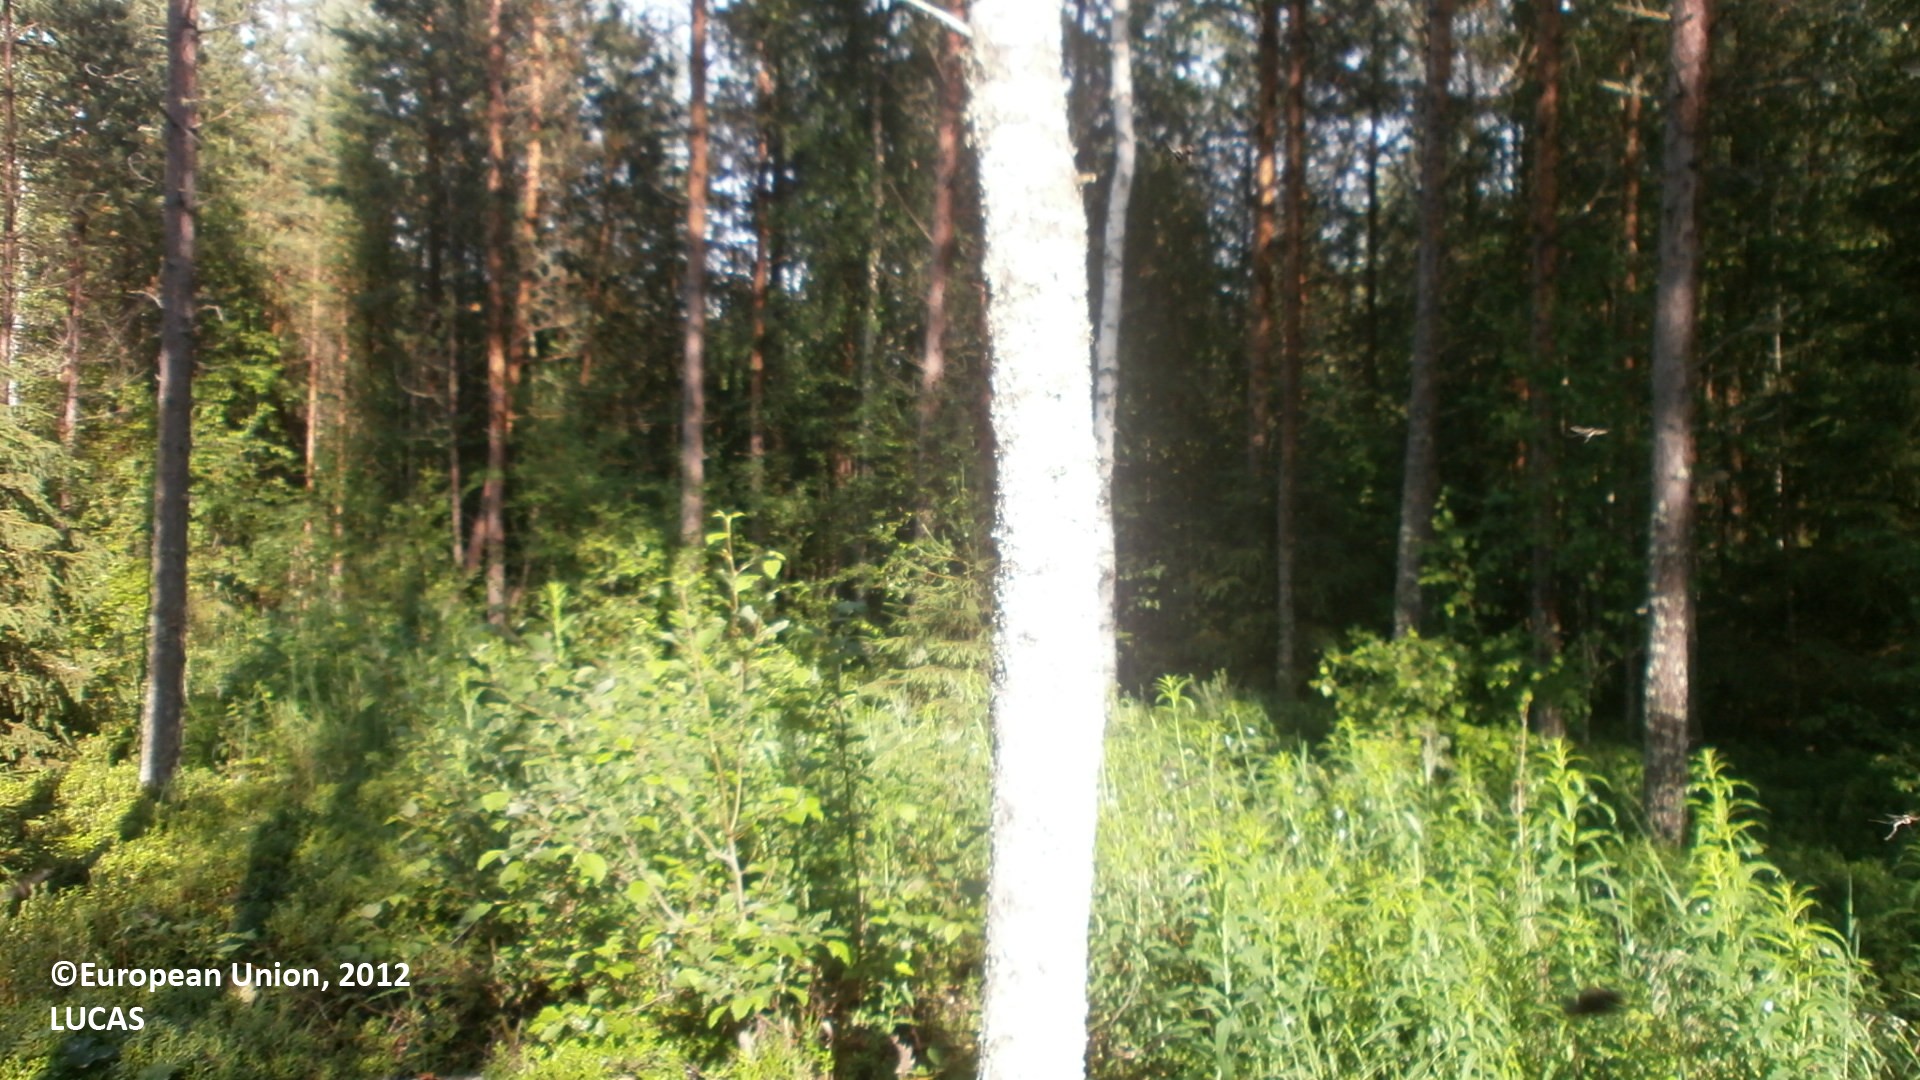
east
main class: Woodland
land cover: Pine dominated mixed woodland
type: boreal forest
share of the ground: 50 - 75 %
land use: Forestry
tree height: > 5 m
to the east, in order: Pine dominated mixed woodland; Ditches and canals; Pine dominated mixed woodland; Ditches and canals; Pine dominated mixed woodland; Ditches and canals; Pine dominated mixed woodland; Ditches and canals; Spruce dominated coniferous woodland; Pine dominated mixed woodland; Pine dominated coniferous woodland
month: July
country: FI
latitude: 64.4425
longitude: 24.3391
